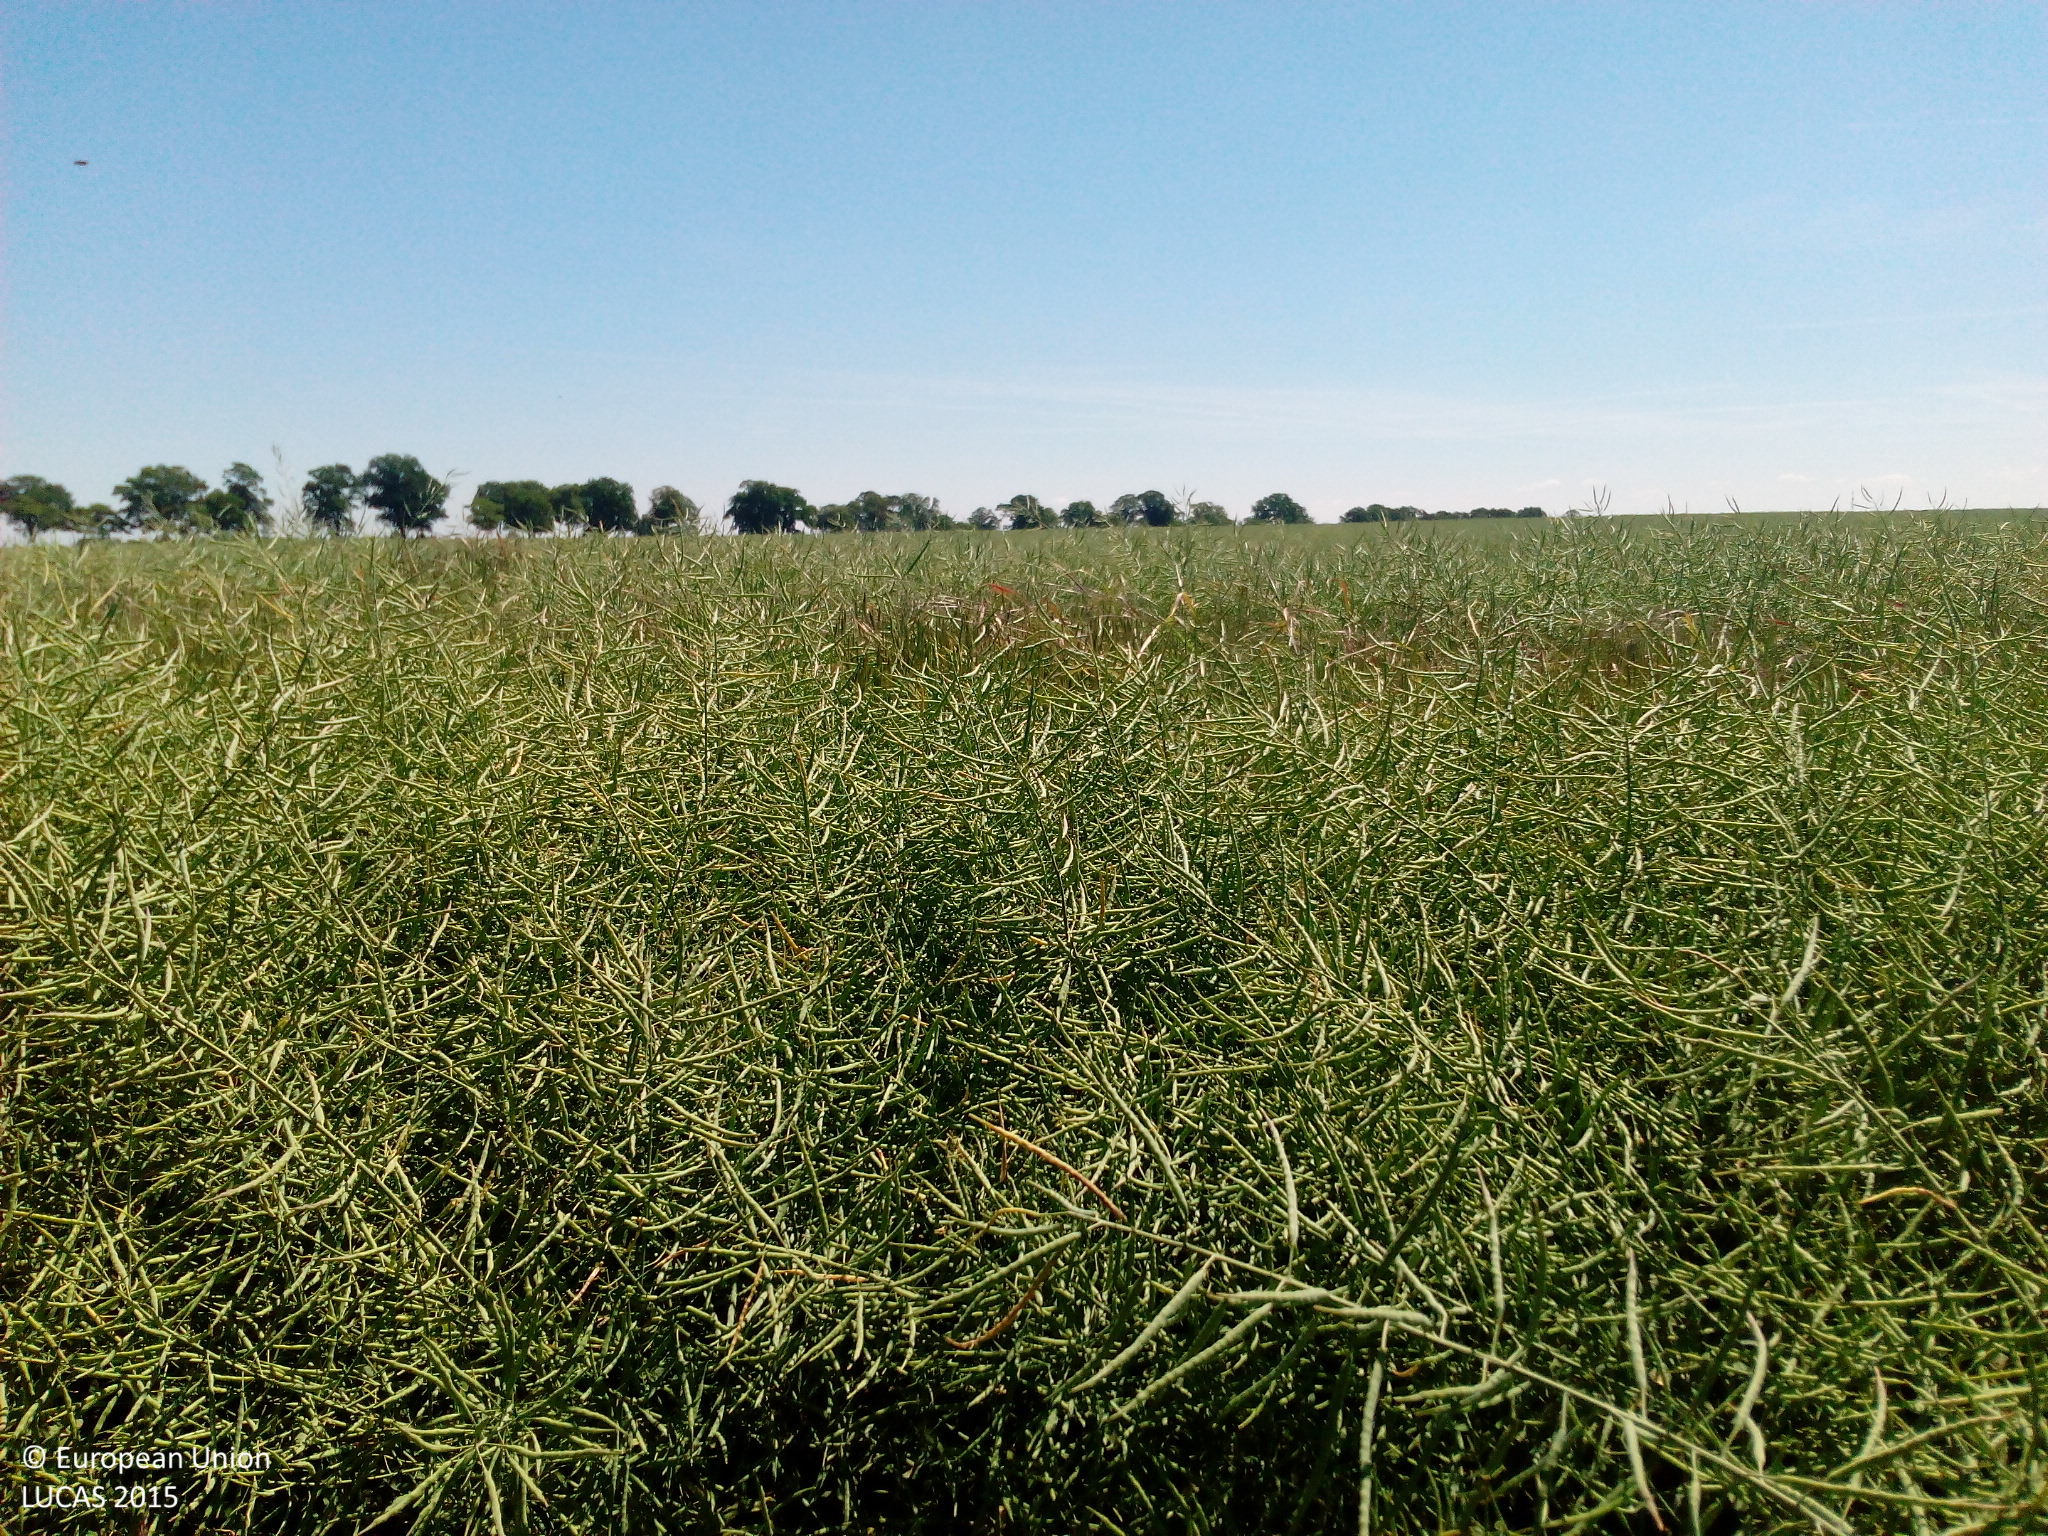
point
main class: Cropland
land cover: Rape and turnip rape
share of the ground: > 75 %
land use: Agriculture (excluding fallow land and kitchen gardens)
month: June
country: DE
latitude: 52.6724
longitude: 12.6172
